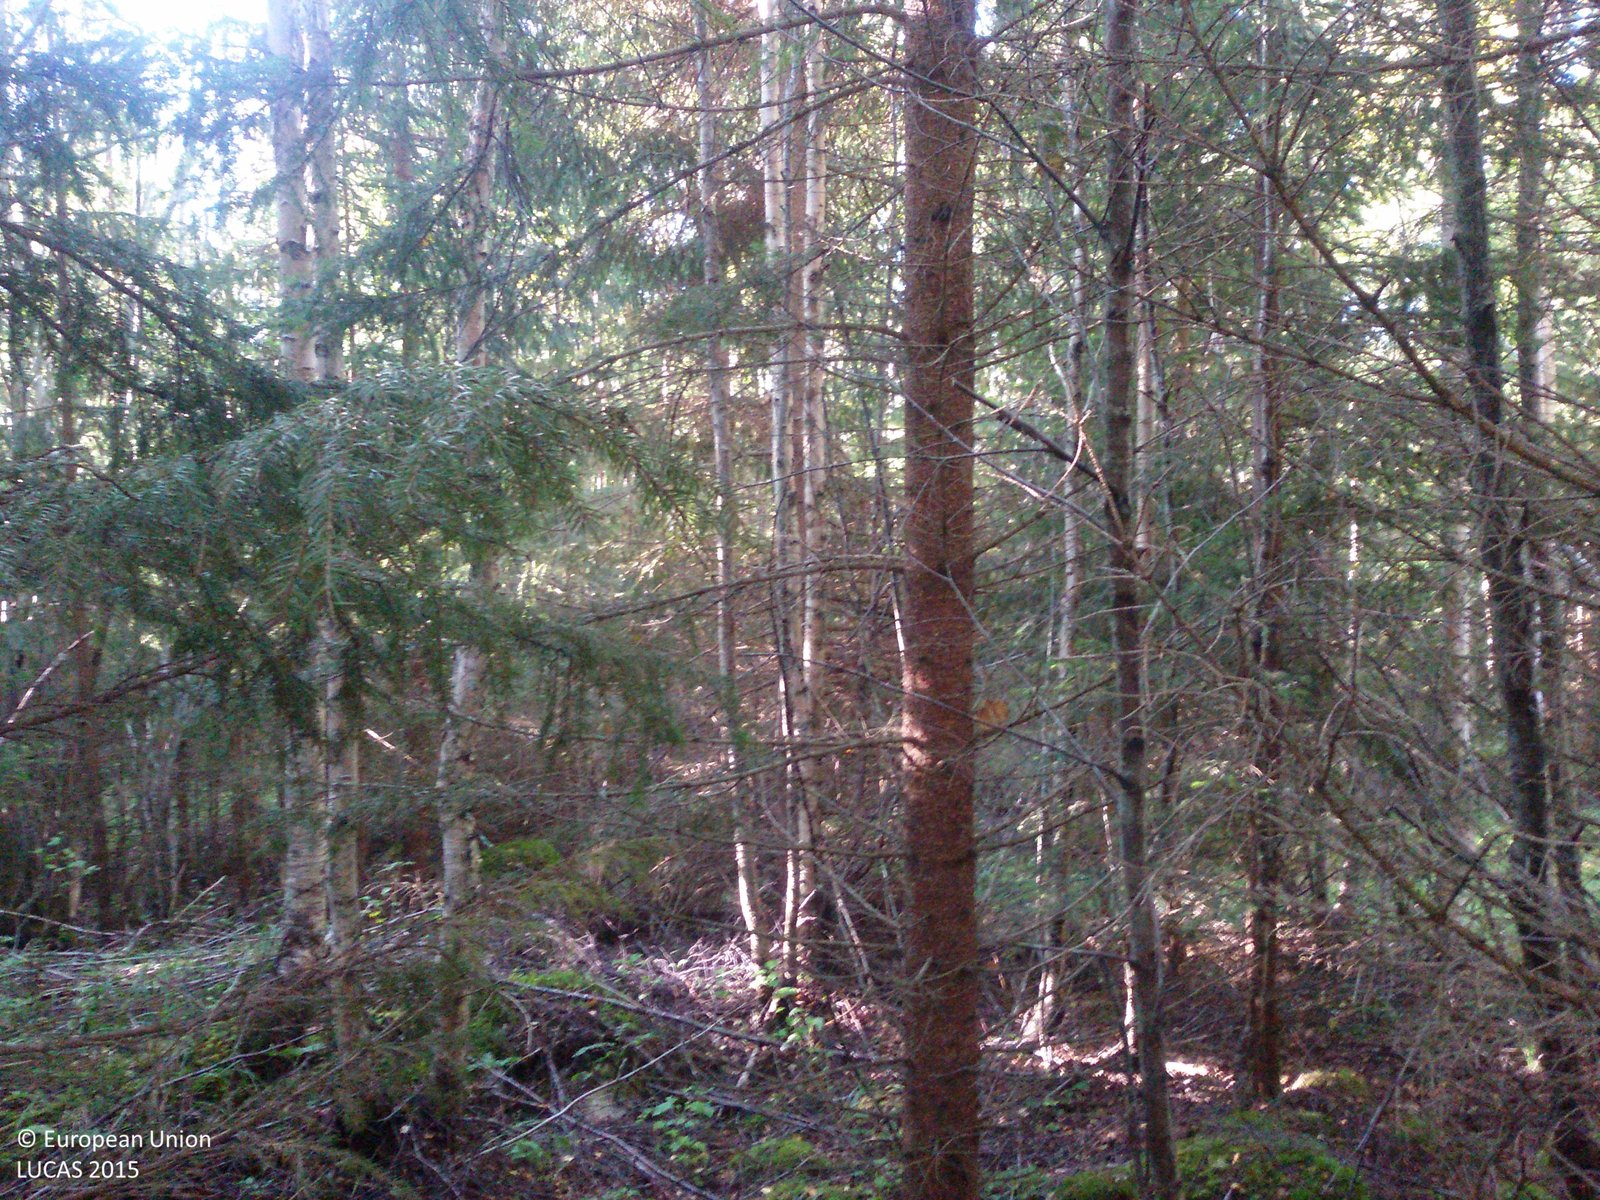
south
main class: Woodland
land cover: Spruce dominated mixed woodland
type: boreal forest
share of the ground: > 75 %
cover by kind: coniferous forest trees 60 %, broadleaved forest trees 20 %, herbaceous plants 10 %, lichens and mosses 10 %
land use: Forestry
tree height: > 5 m
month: September
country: SE
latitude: 60.8570
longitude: 15.3064
